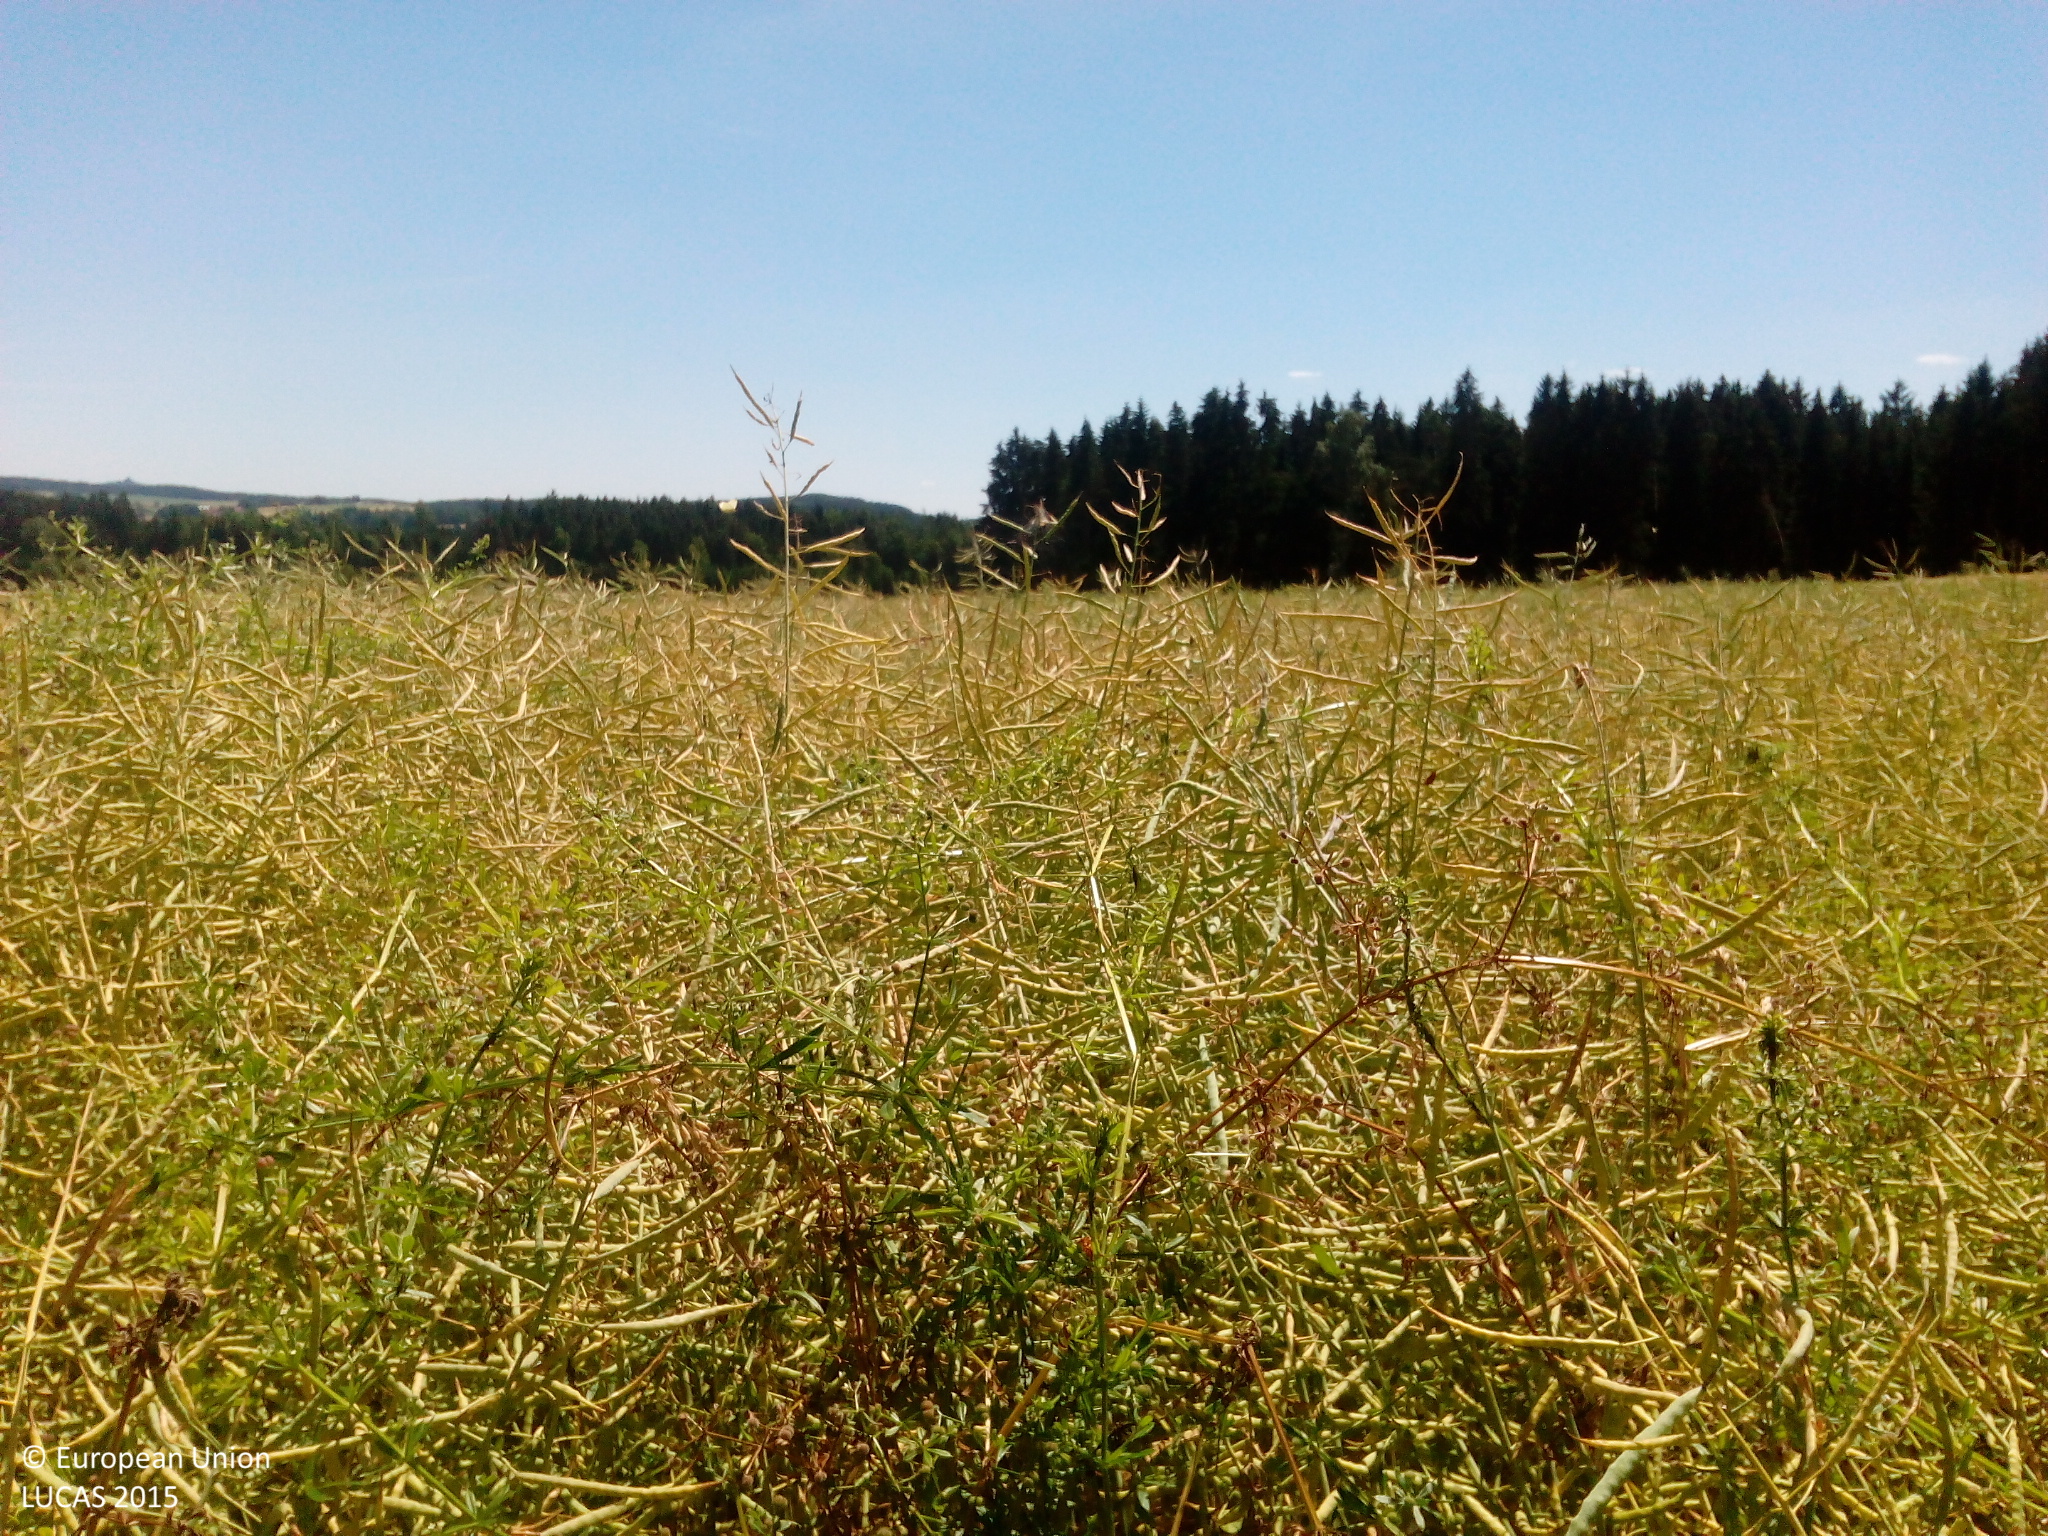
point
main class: Cropland
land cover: Rape and turnip rape
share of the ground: > 75 %
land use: Agriculture (excluding fallow land and kitchen gardens)
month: July
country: DE
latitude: 49.7846
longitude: 12.2357
